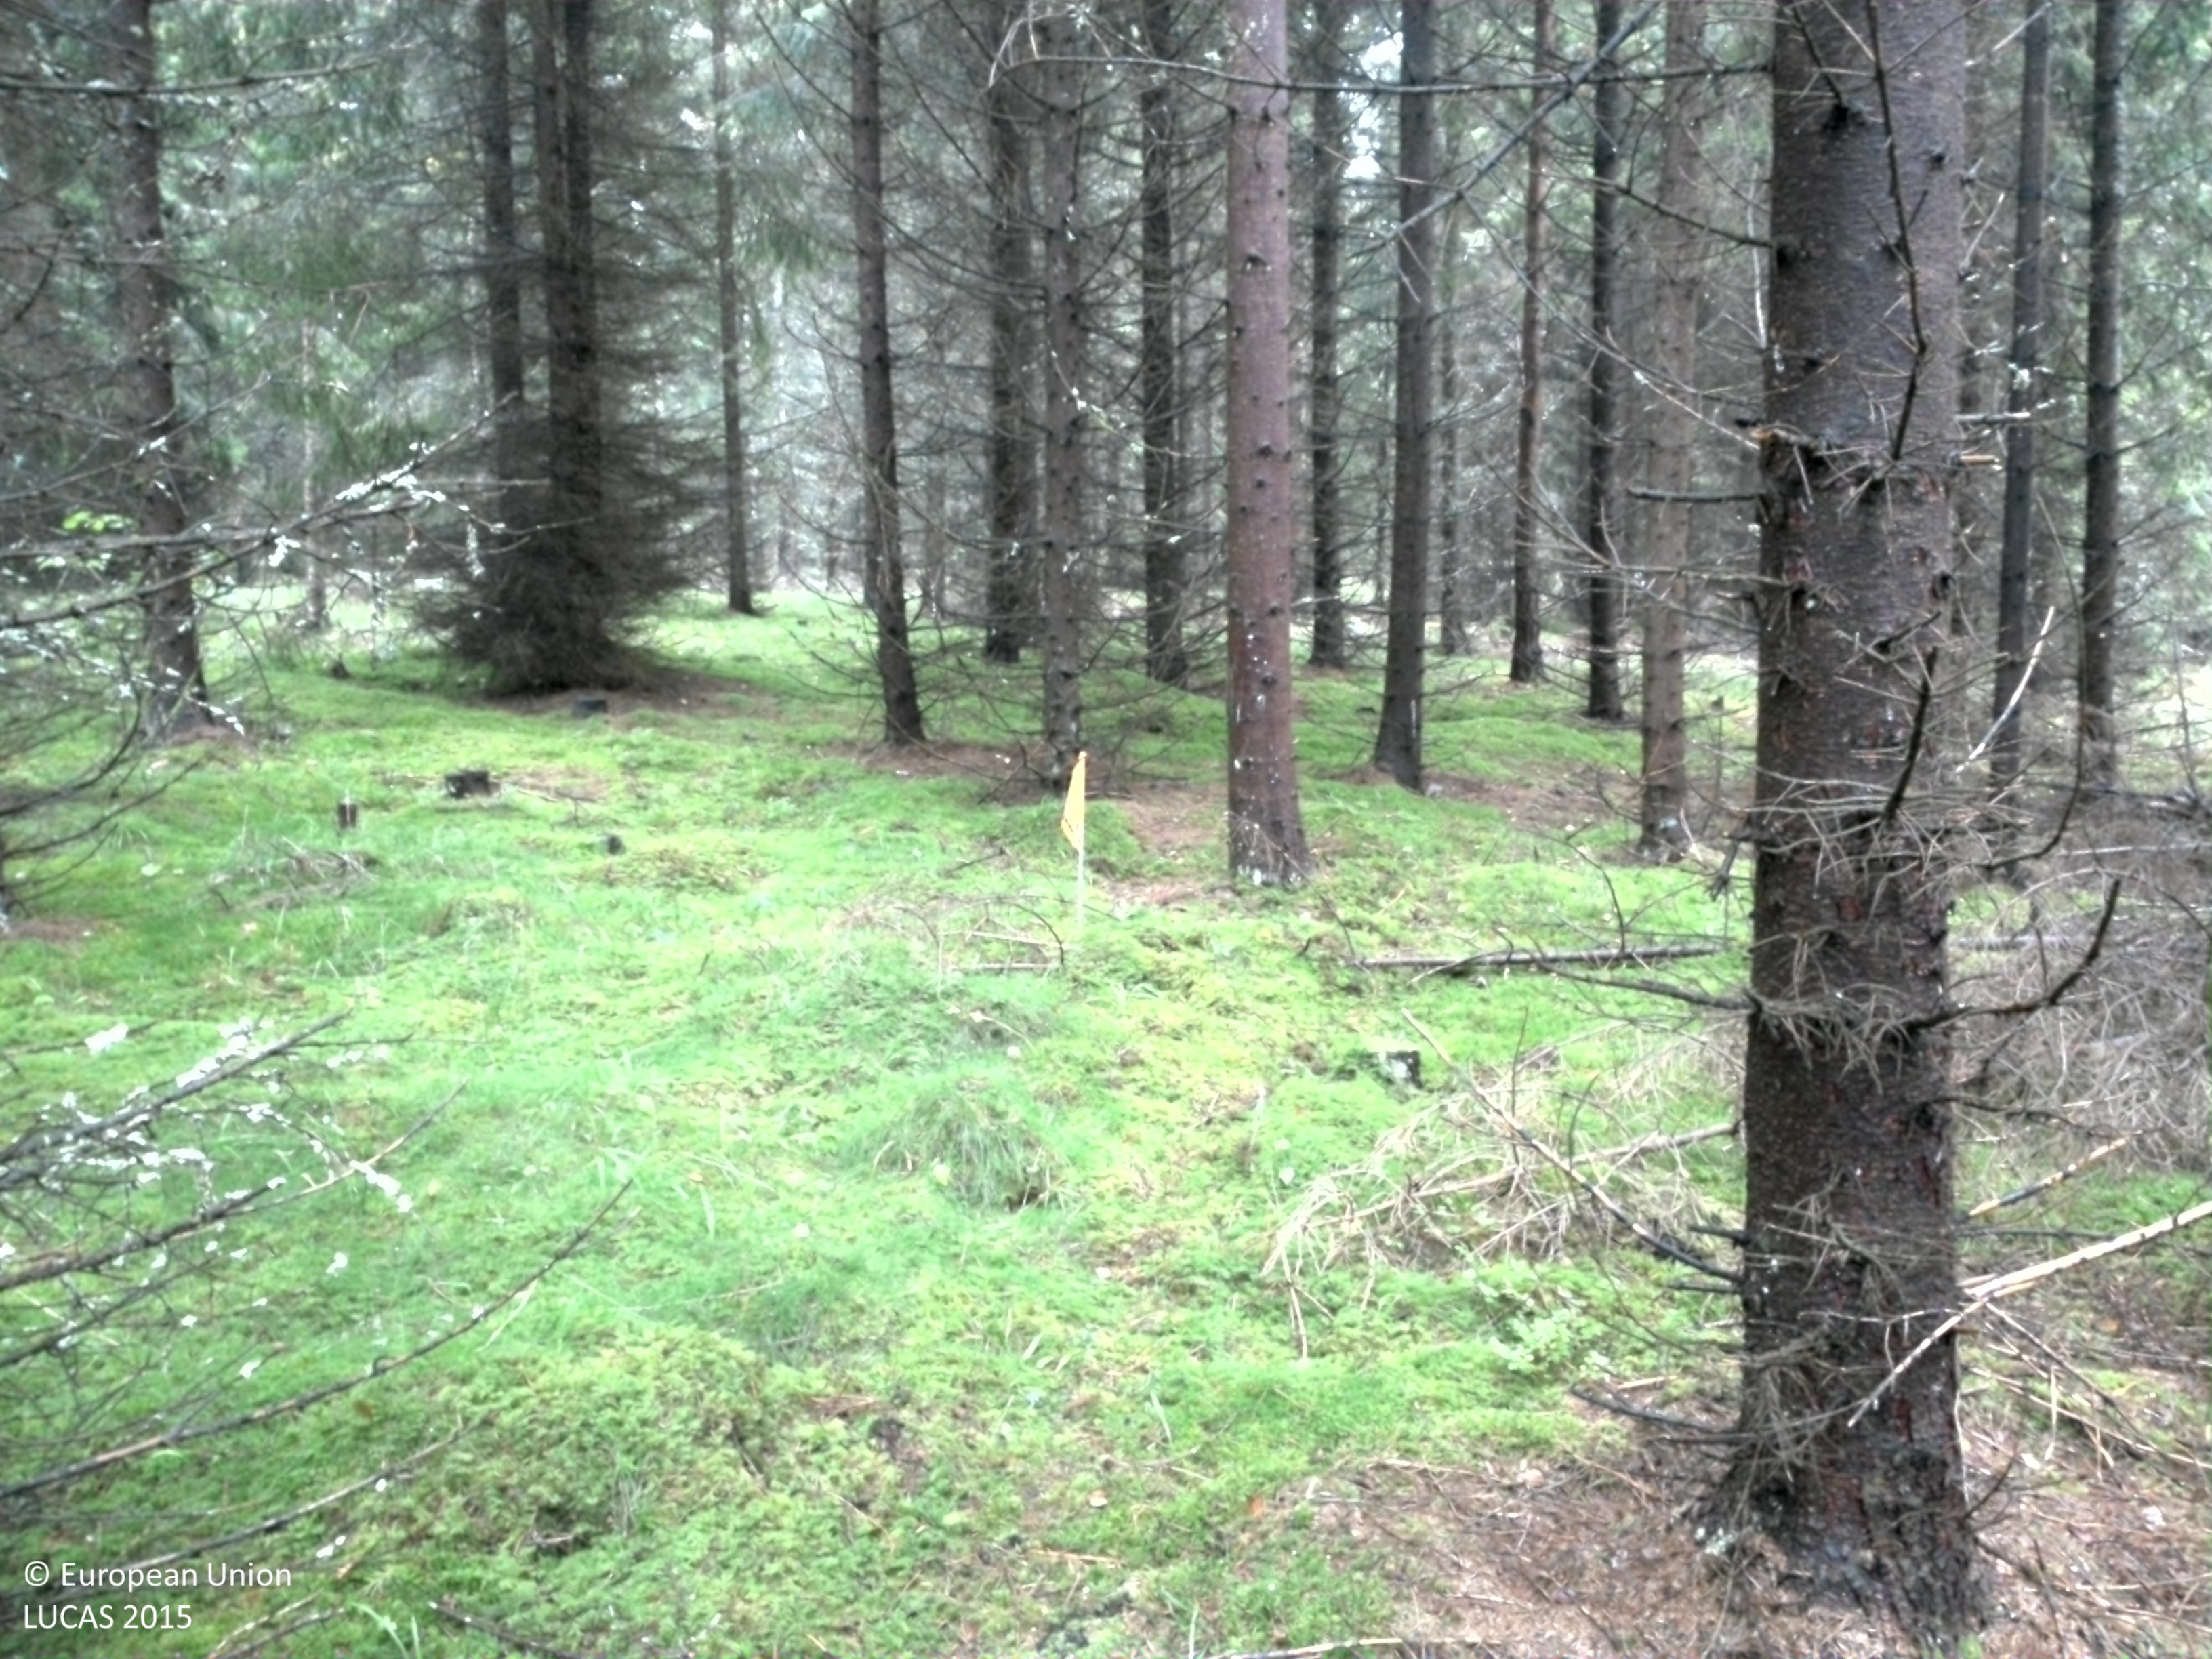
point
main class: Woodland
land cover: Spruce dominated coniferous woodland
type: boreal forest
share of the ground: 50 - 75 %
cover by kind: coniferous forest trees 60 %, lichens and mosses 35 %, herbaceous plants 5 %
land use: Forestry
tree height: > 5 m
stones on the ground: > 50 %
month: September
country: SE
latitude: 58.9334
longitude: 14.0407
